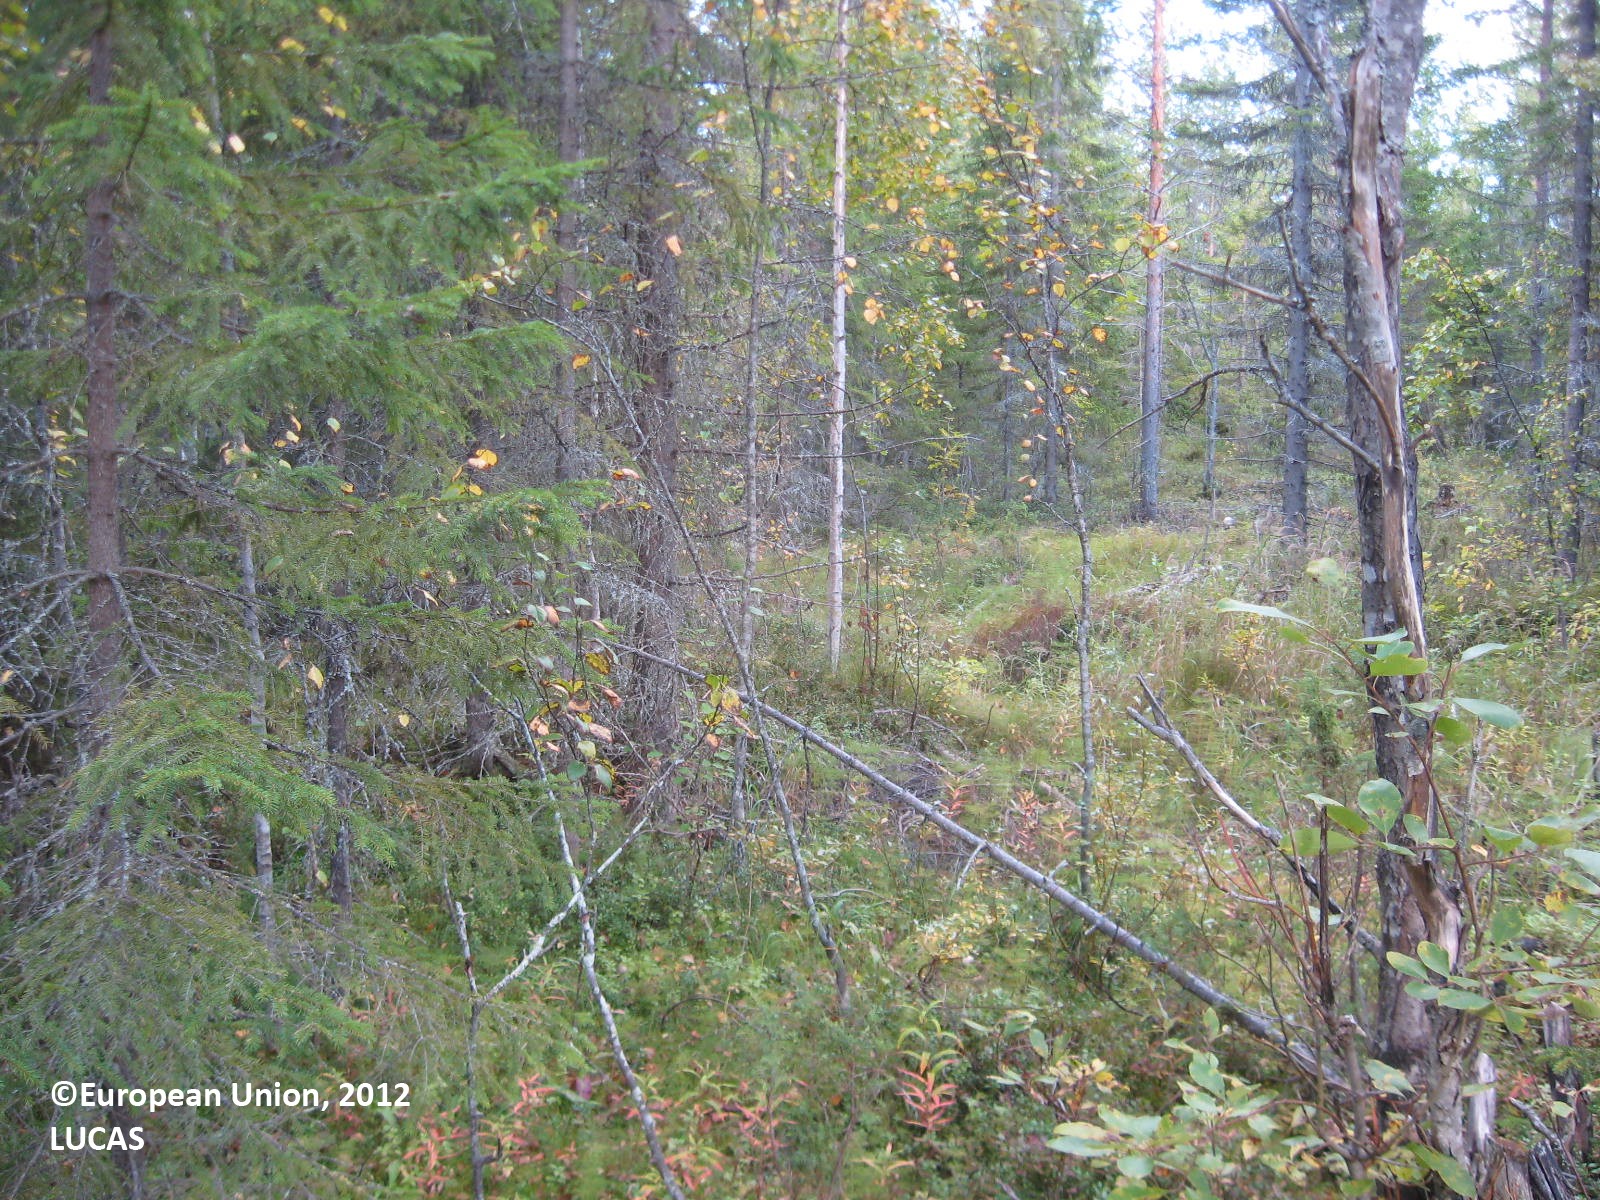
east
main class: Woodland
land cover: Other coniferous woodland
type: boreal forest
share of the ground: > 75 %
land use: Forestry
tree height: > 5 m
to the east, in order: Other coniferous woodland; Ditches and canals; Other coniferous woodland; Pine dominated coniferous woodland; Grassland without tree/shrub cover; Pine dominated coniferous woodland
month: August
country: FI
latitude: 63.9477
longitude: 29.8472
